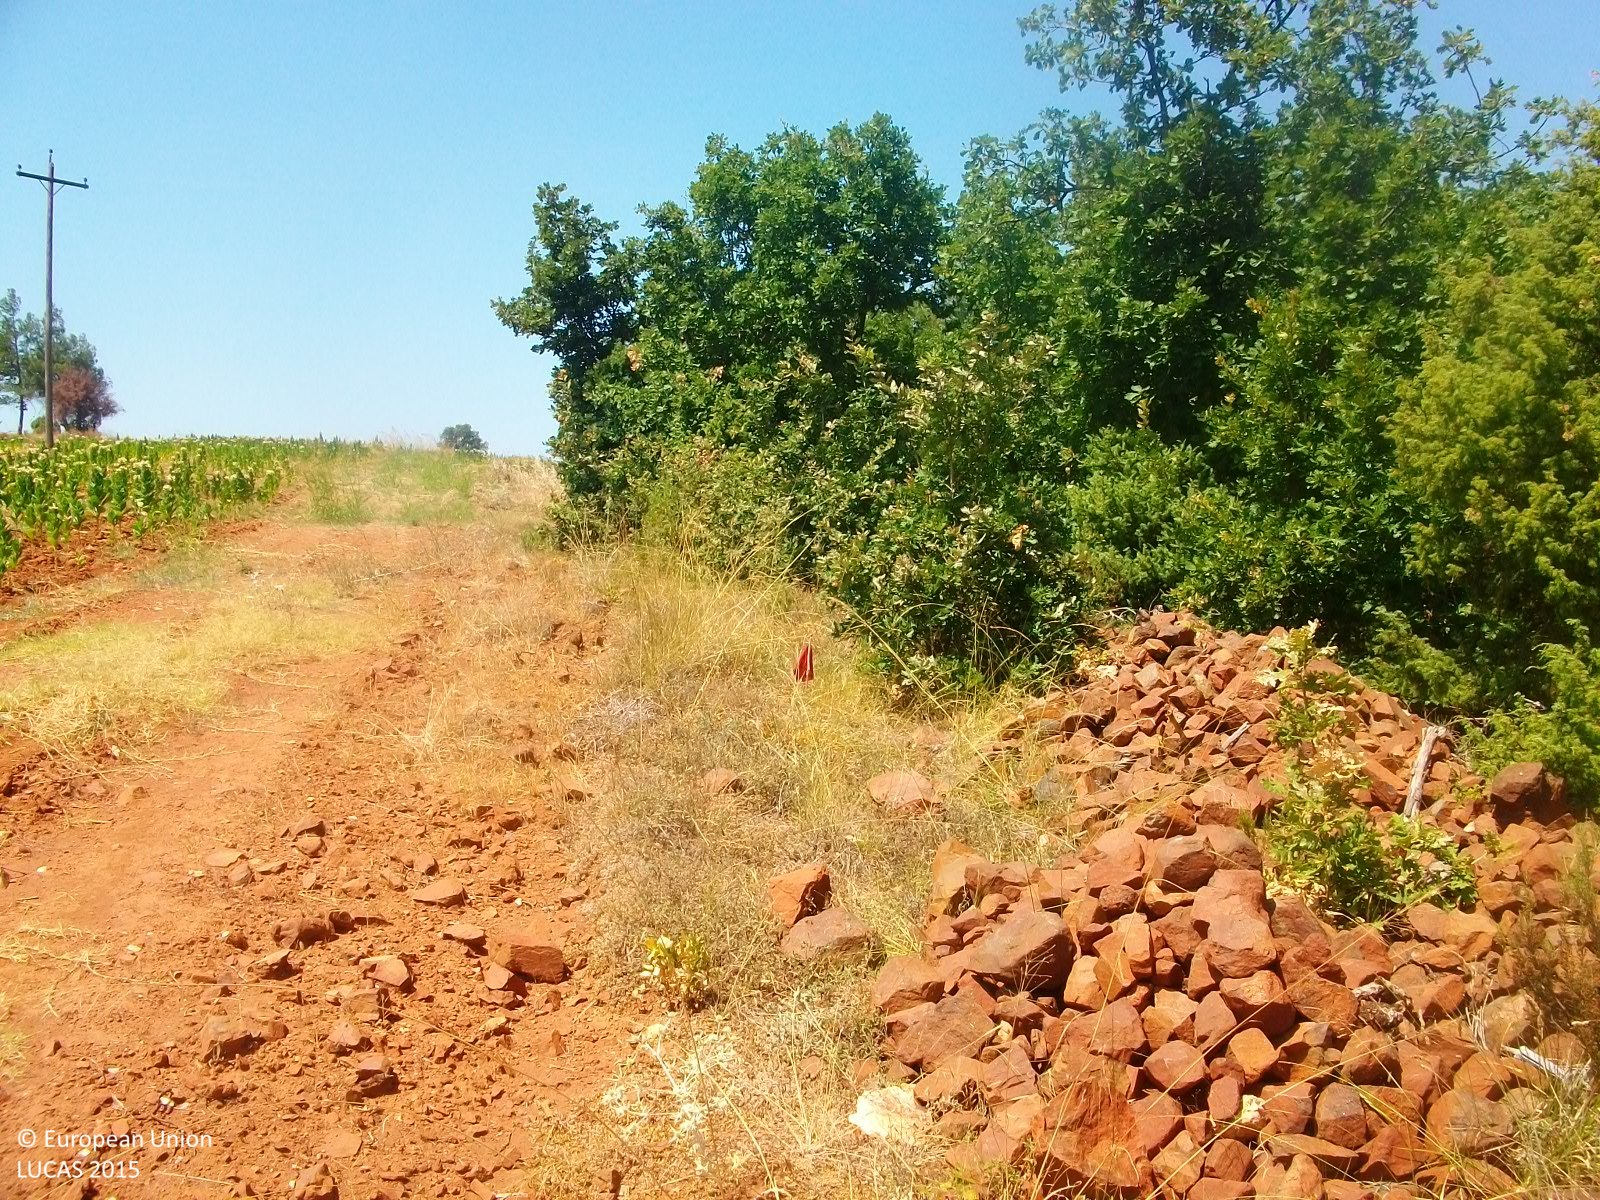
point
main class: Woodland
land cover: Broadleaved woodland
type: thermophilous deciduous forest
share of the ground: > 75 %
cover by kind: broadleaved forest trees 80 %, shrubs 10 %, herbaceous plants 10 %
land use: Forestry
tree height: > 5 m
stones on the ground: 10 - 25 %
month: August
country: GR
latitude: 41.2317
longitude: 26.1859
